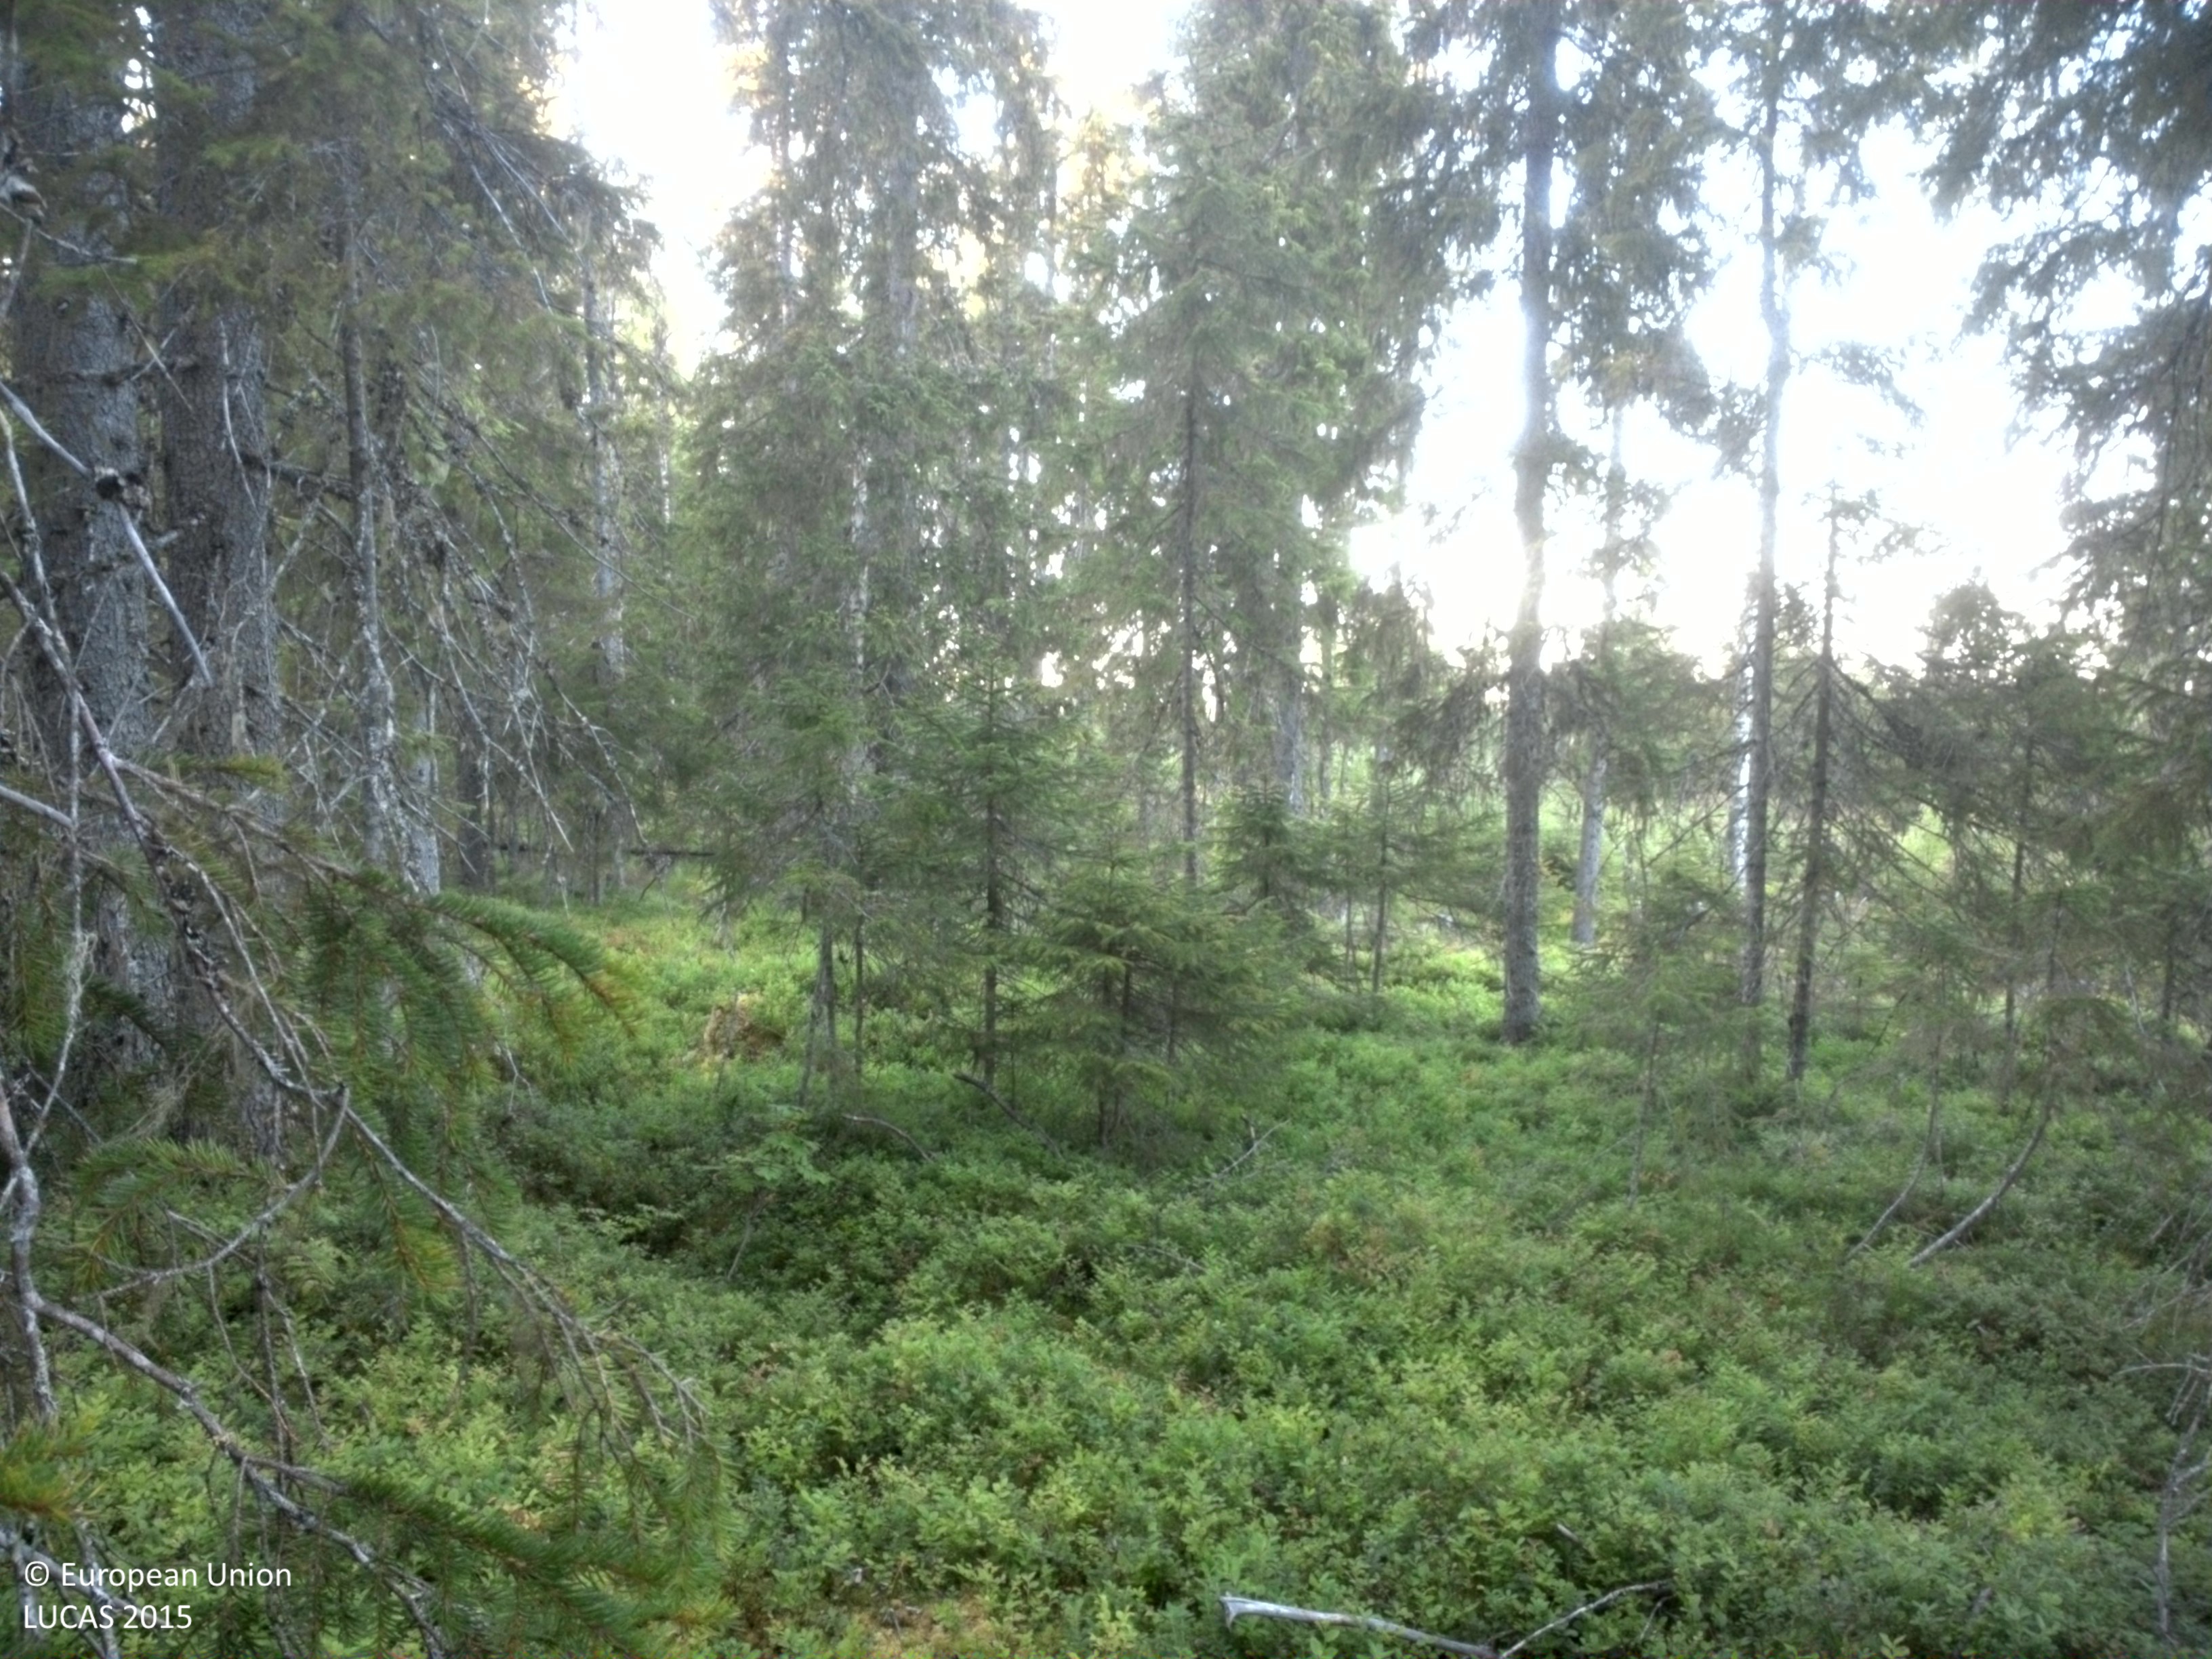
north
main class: Woodland
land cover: Spruce dominated coniferous woodland
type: boreal forest
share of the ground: 50 - 75 %
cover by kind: coniferous forest trees 60 %, shrubs 40 %
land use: Forestry
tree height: > 5 m
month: September
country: SE
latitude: 64.7134
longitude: 19.8118
